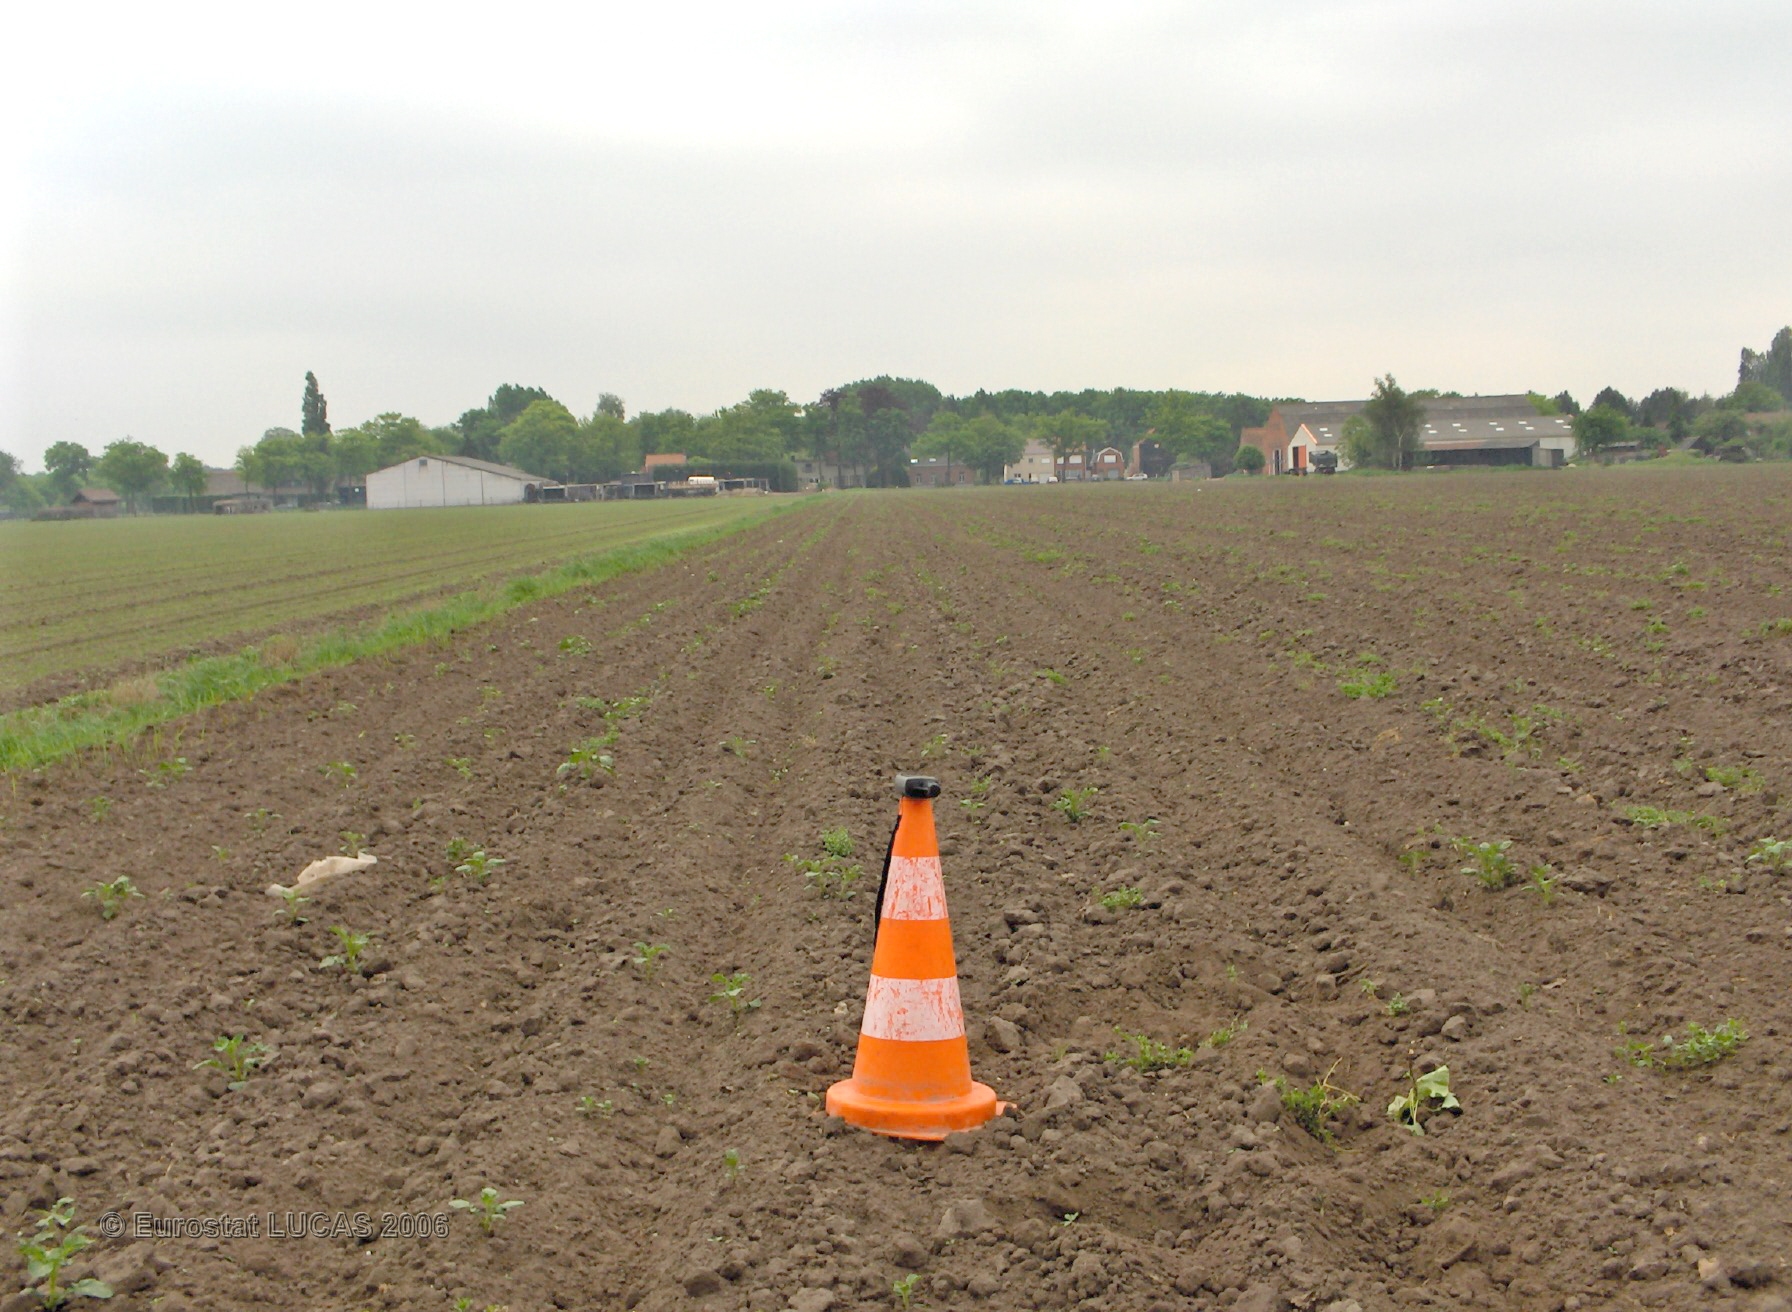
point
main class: Bare land
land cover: Bare land
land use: Agriculture (excluding fallow land and kitchen gardens)
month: May
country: BE
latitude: 51.3435
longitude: 4.3821
